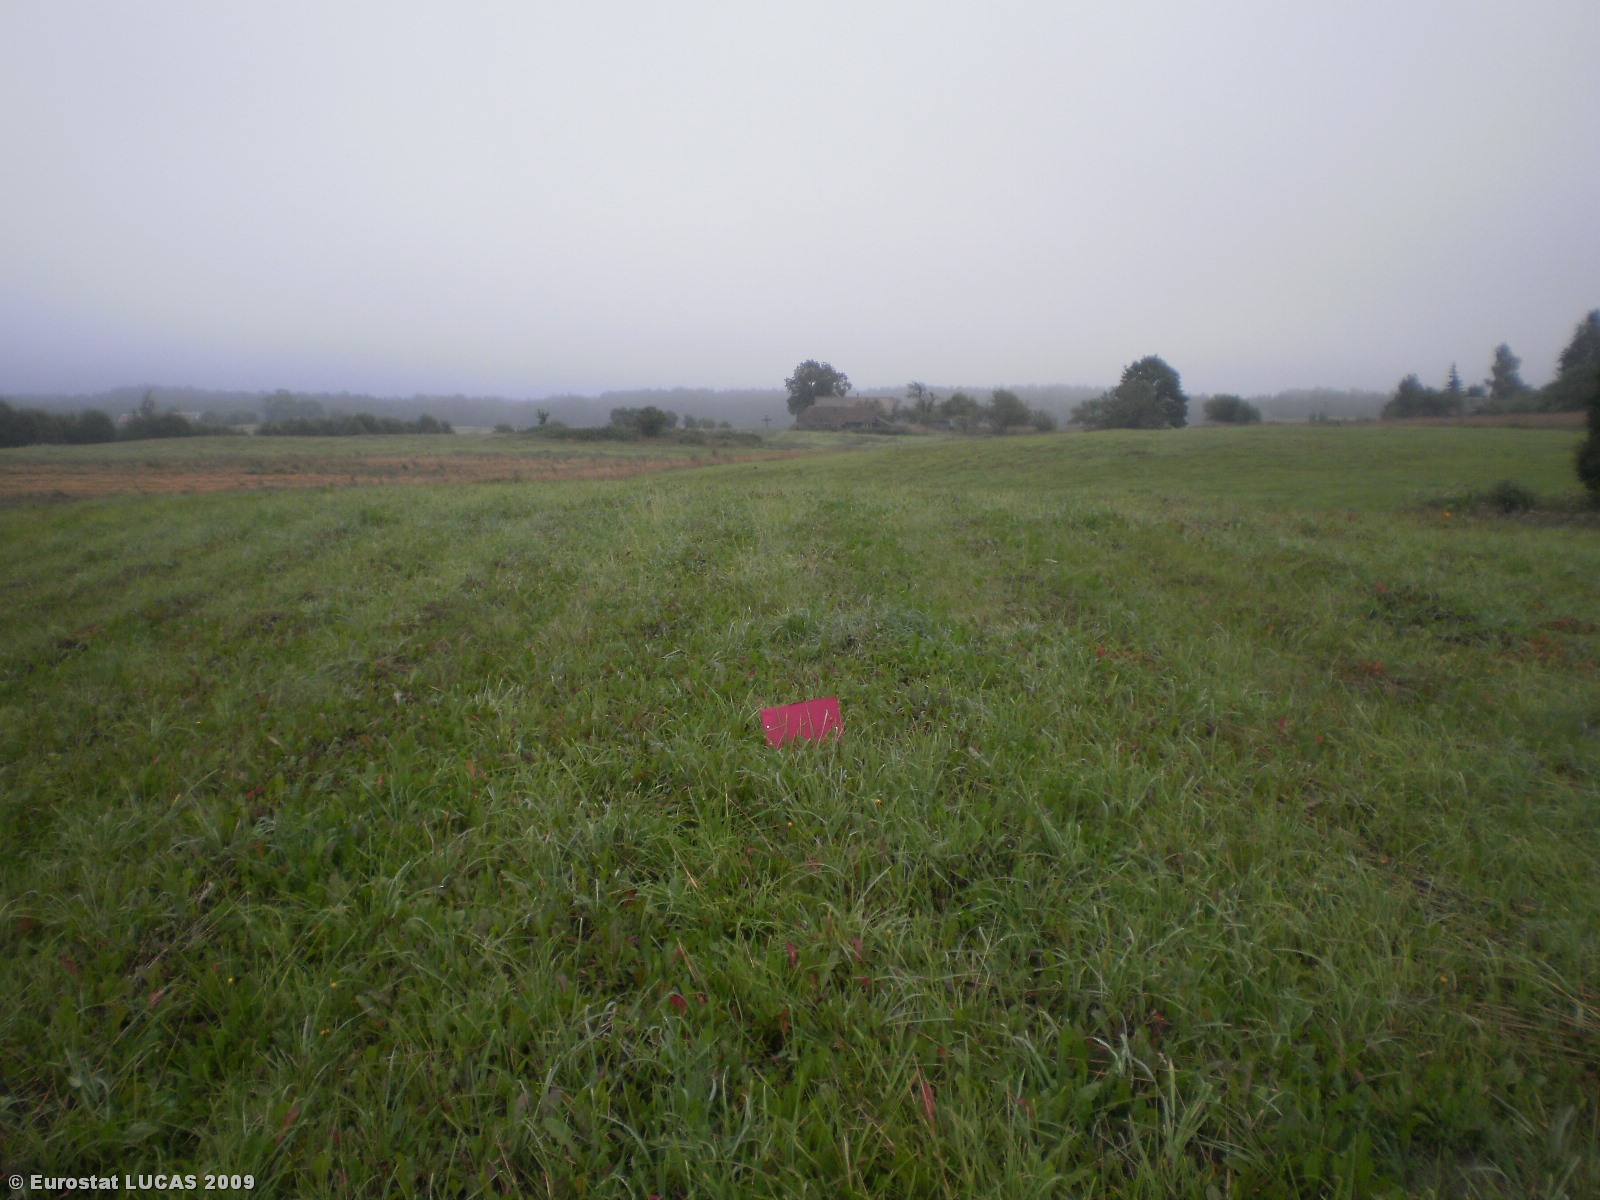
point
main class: Grassland
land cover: Grassland without tree/shrub cover
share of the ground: > 75 %
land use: Agriculture (excluding fallow land and kitchen gardens)
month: August
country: LT
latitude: 55.3397
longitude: 25.5621
